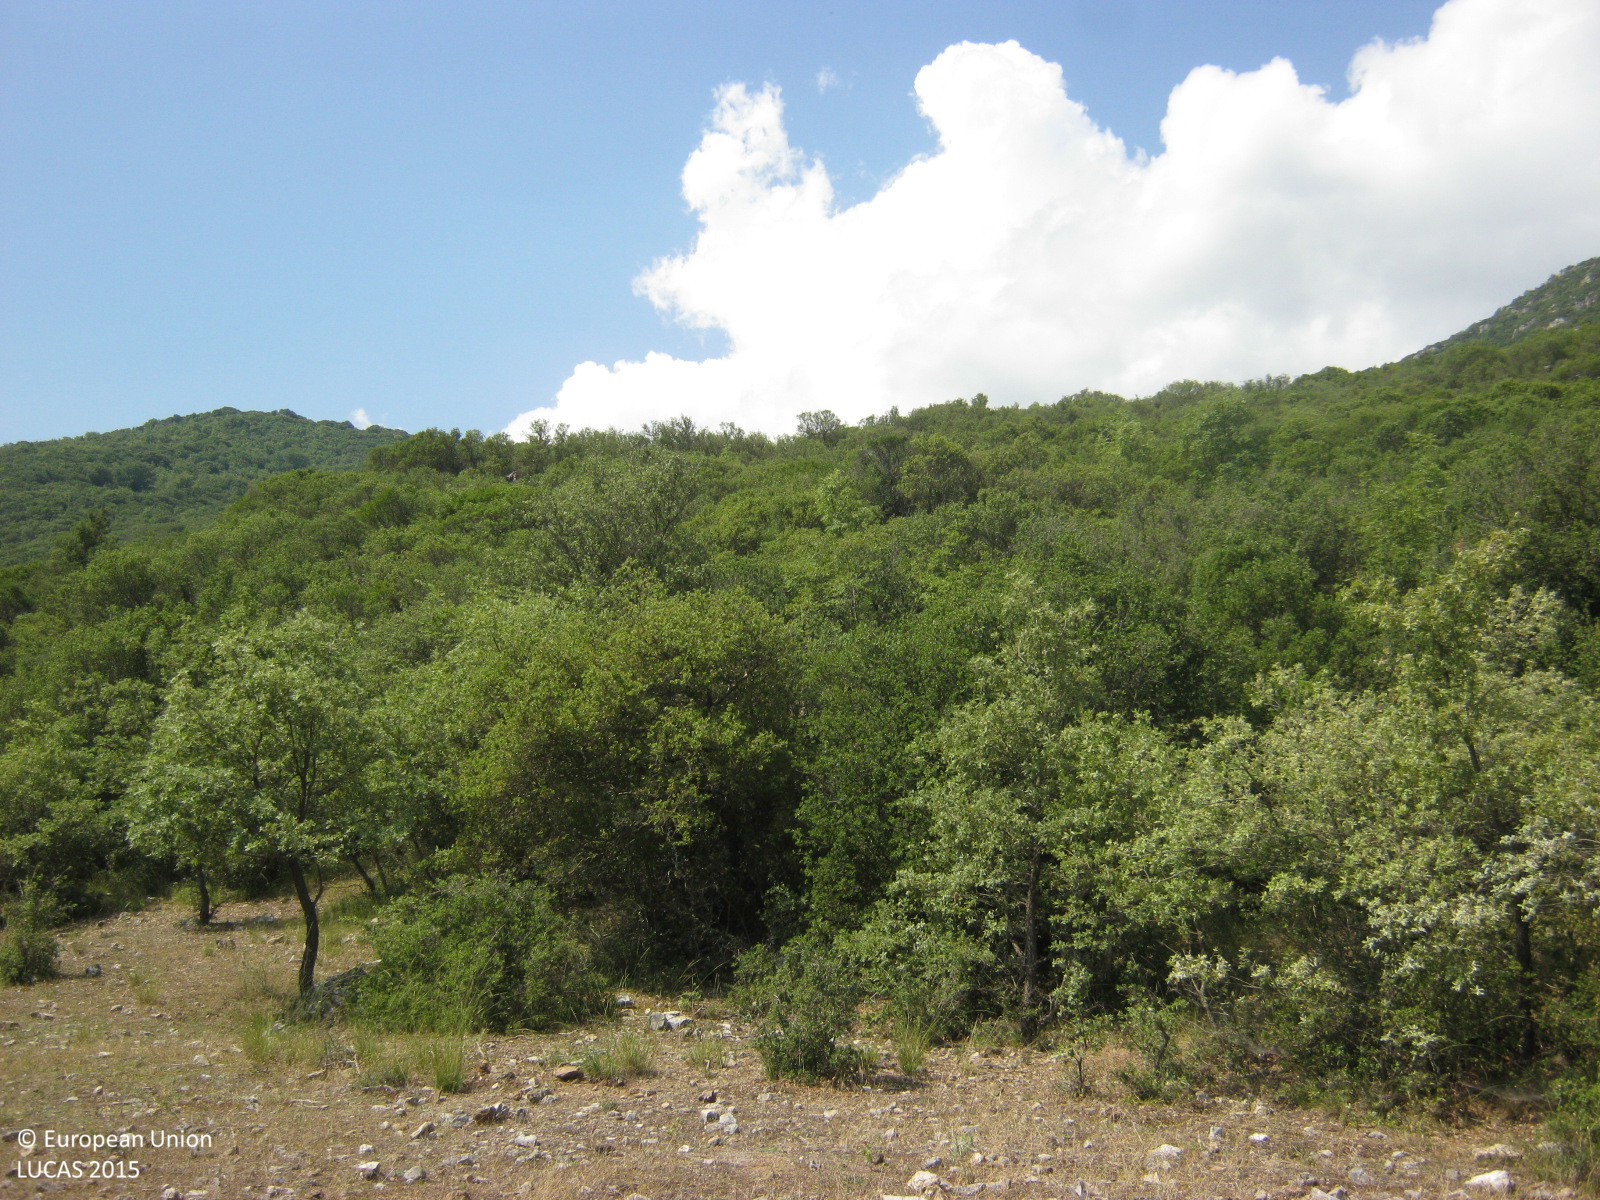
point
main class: Woodland
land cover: Broadleaved woodland
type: thermophilous deciduous forest
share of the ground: > 75 %
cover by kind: broadleaved forest trees 90 %, shrubs 5 %, herbaceous plants 5 %
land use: Semi-natural and natural areas not in use
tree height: > 5 m
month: July
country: GR
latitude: 37.7511
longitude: 22.1646
